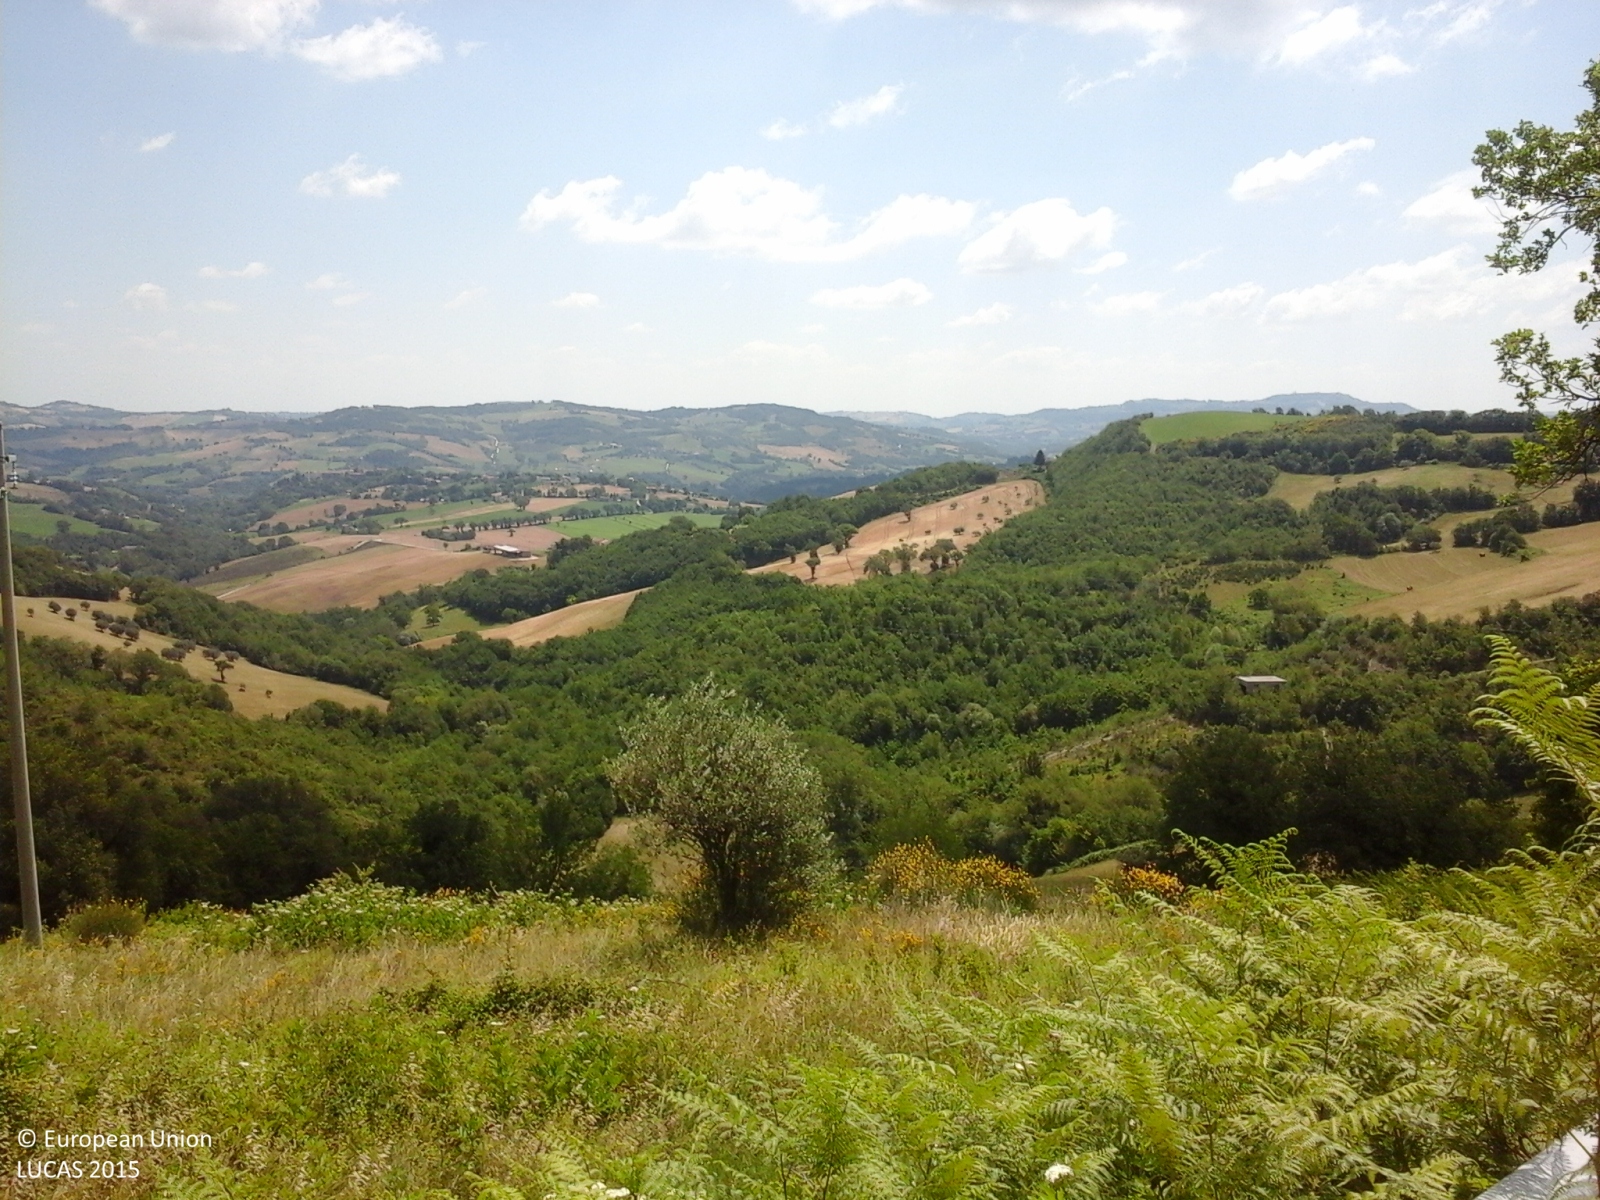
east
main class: Woodland
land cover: Broadleaved woodland
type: thermophilous deciduous forest
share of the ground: > 75 %
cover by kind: broadleaved forest trees 90 %, shrubs 5 %, herbaceous plants 5 %
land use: Forestry
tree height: > 5 m
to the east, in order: Broadleaved woodland; Spruce dominated coniferous woodland; Broadleaved woodland; Spontaneously vegetated surfaces
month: June
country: IT
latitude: 43.1636
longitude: 13.2015
